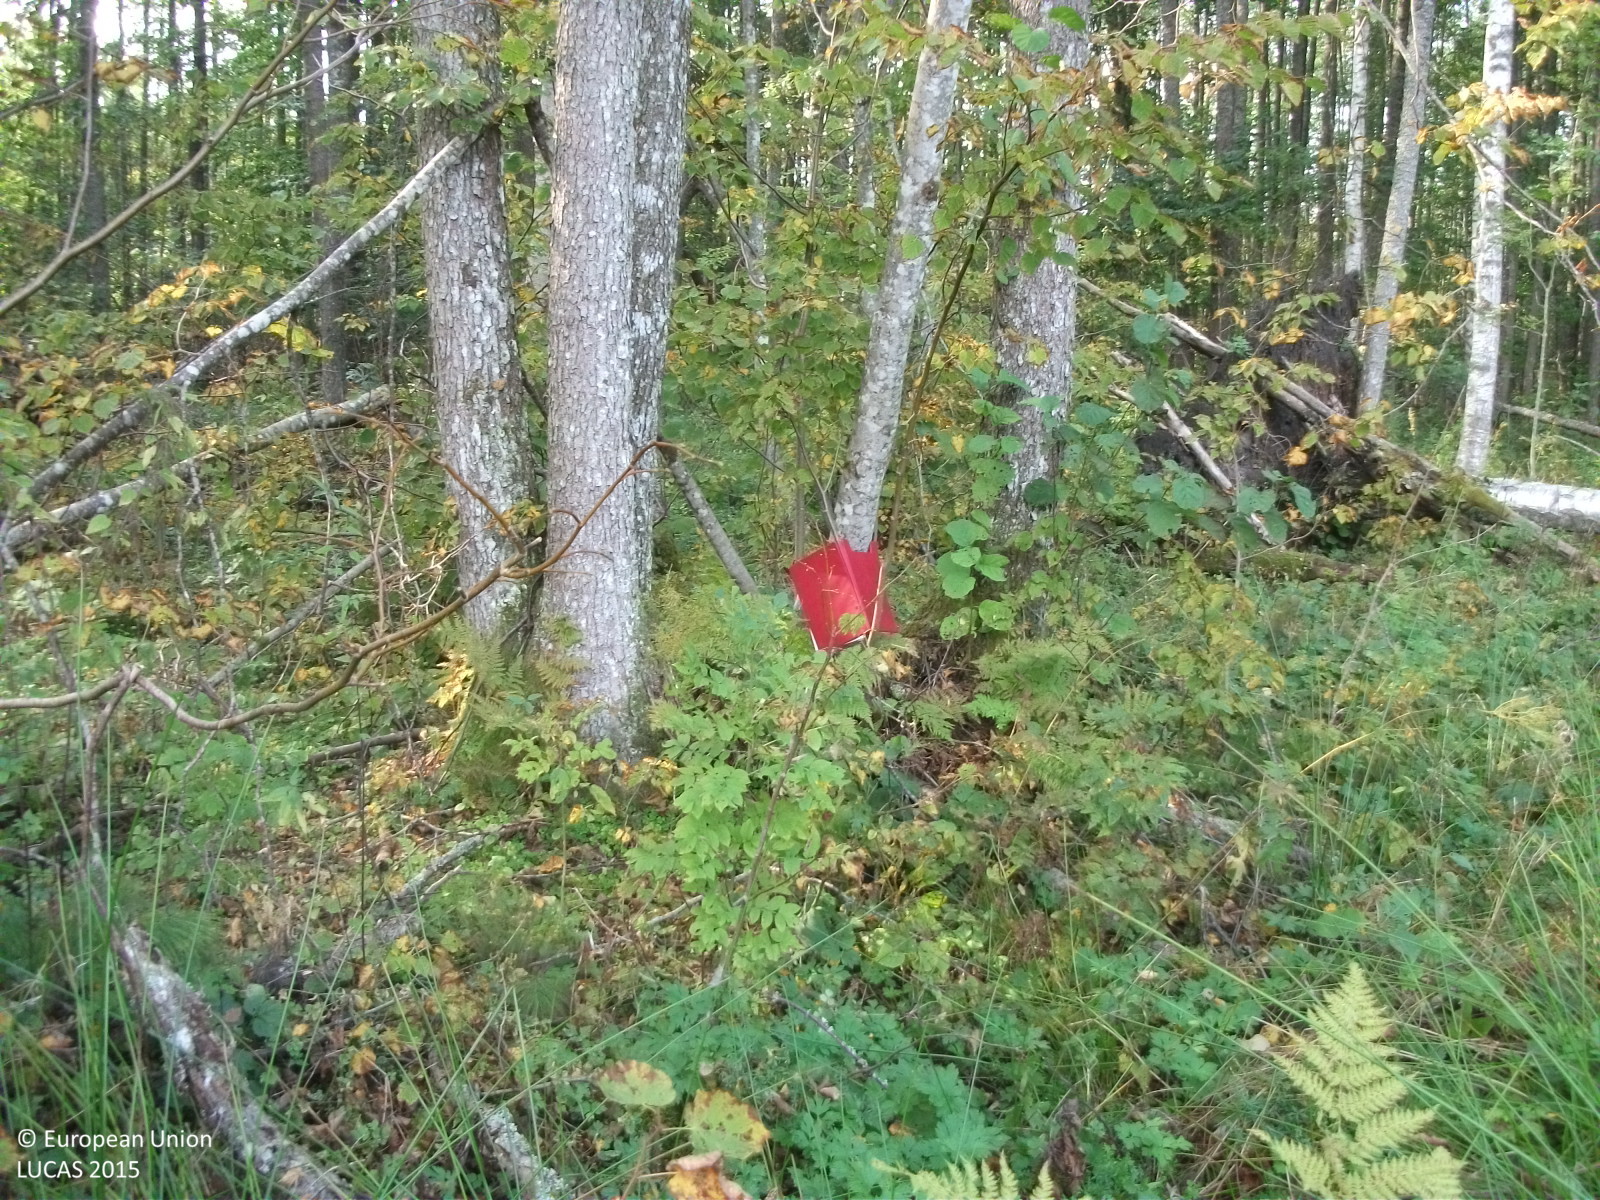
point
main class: Woodland
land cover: Broadleaved woodland
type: non-riverine alder, birch or aspen forest
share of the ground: > 75 %
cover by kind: broadleaved forest trees 80 %, herbaceous plants 10 %, shrubs 5 %
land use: Forestry
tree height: > 5 m
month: September
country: LV
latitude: 57.8383
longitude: 24.5934
